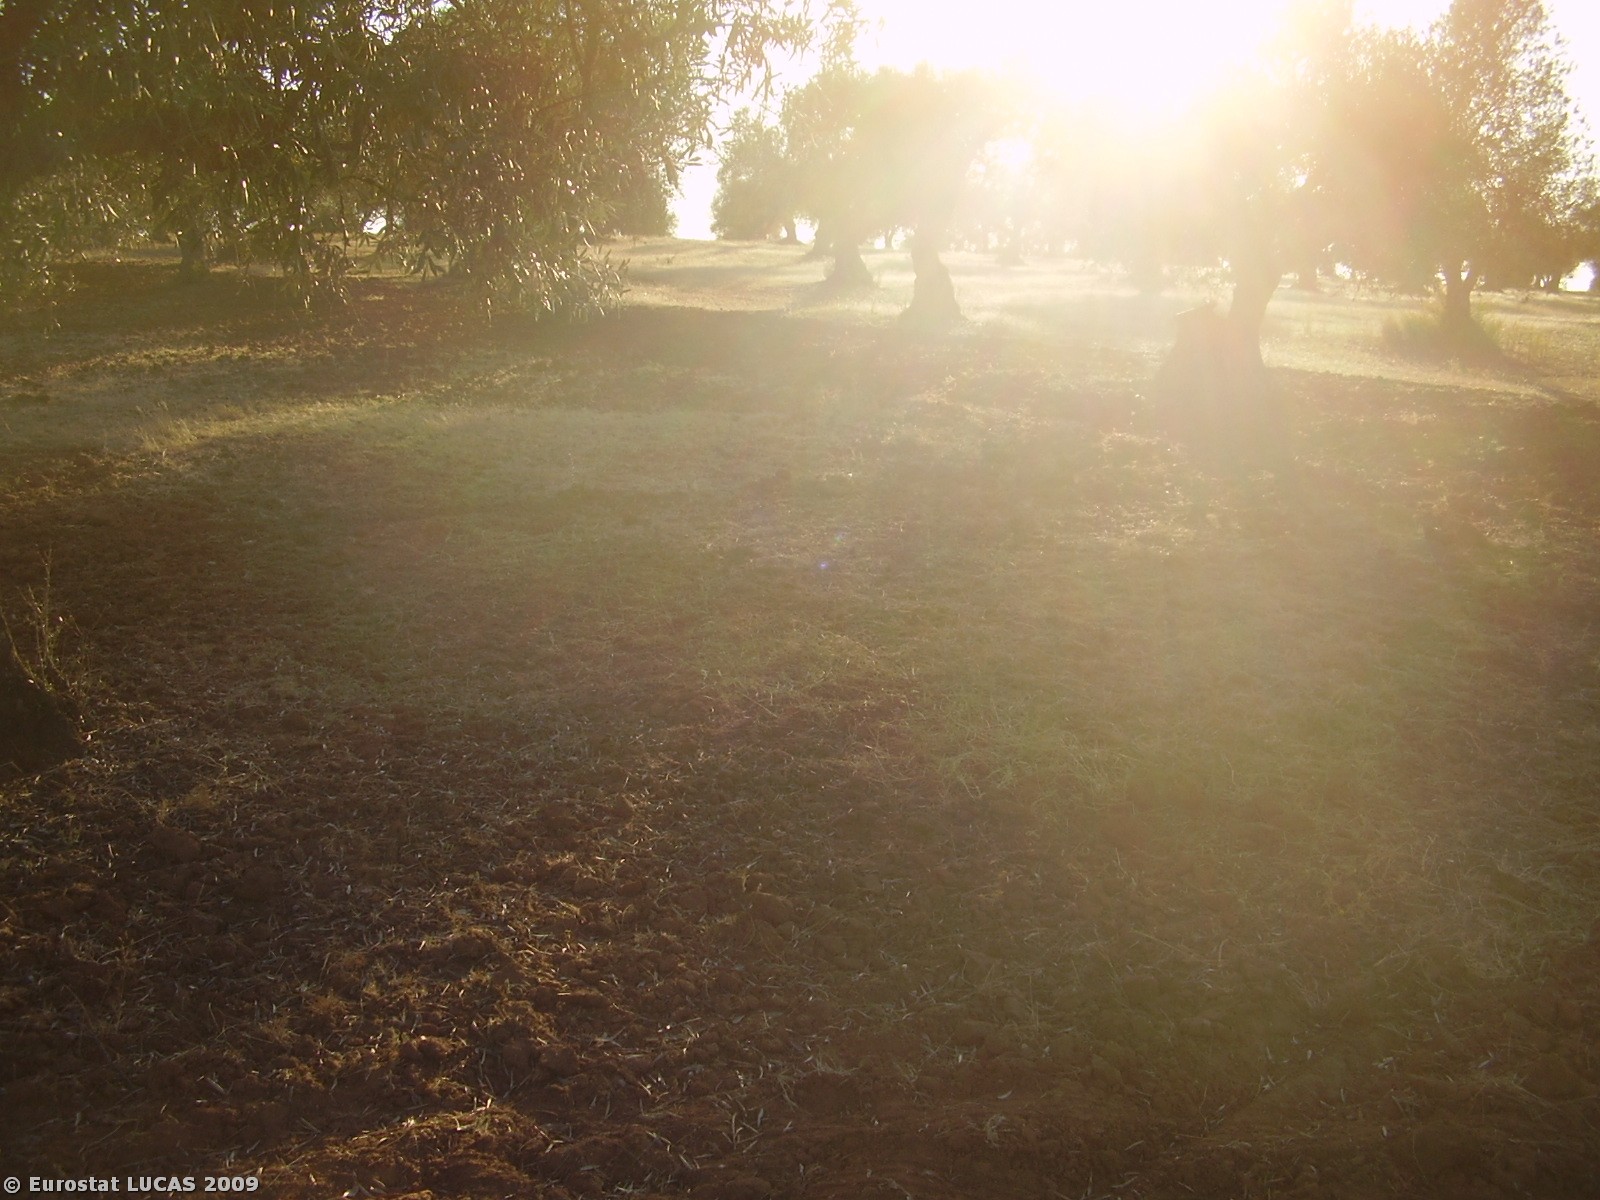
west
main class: Cropland
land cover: Olive groves
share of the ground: 10 - 25 %
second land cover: Spontaneously vegetated surfaces
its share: 10 - 25 %
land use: Agriculture (excluding fallow land and kitchen gardens)
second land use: Fallow land
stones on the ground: 25 - 50 %
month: August
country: PT
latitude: 38.0419
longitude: -7.5573
